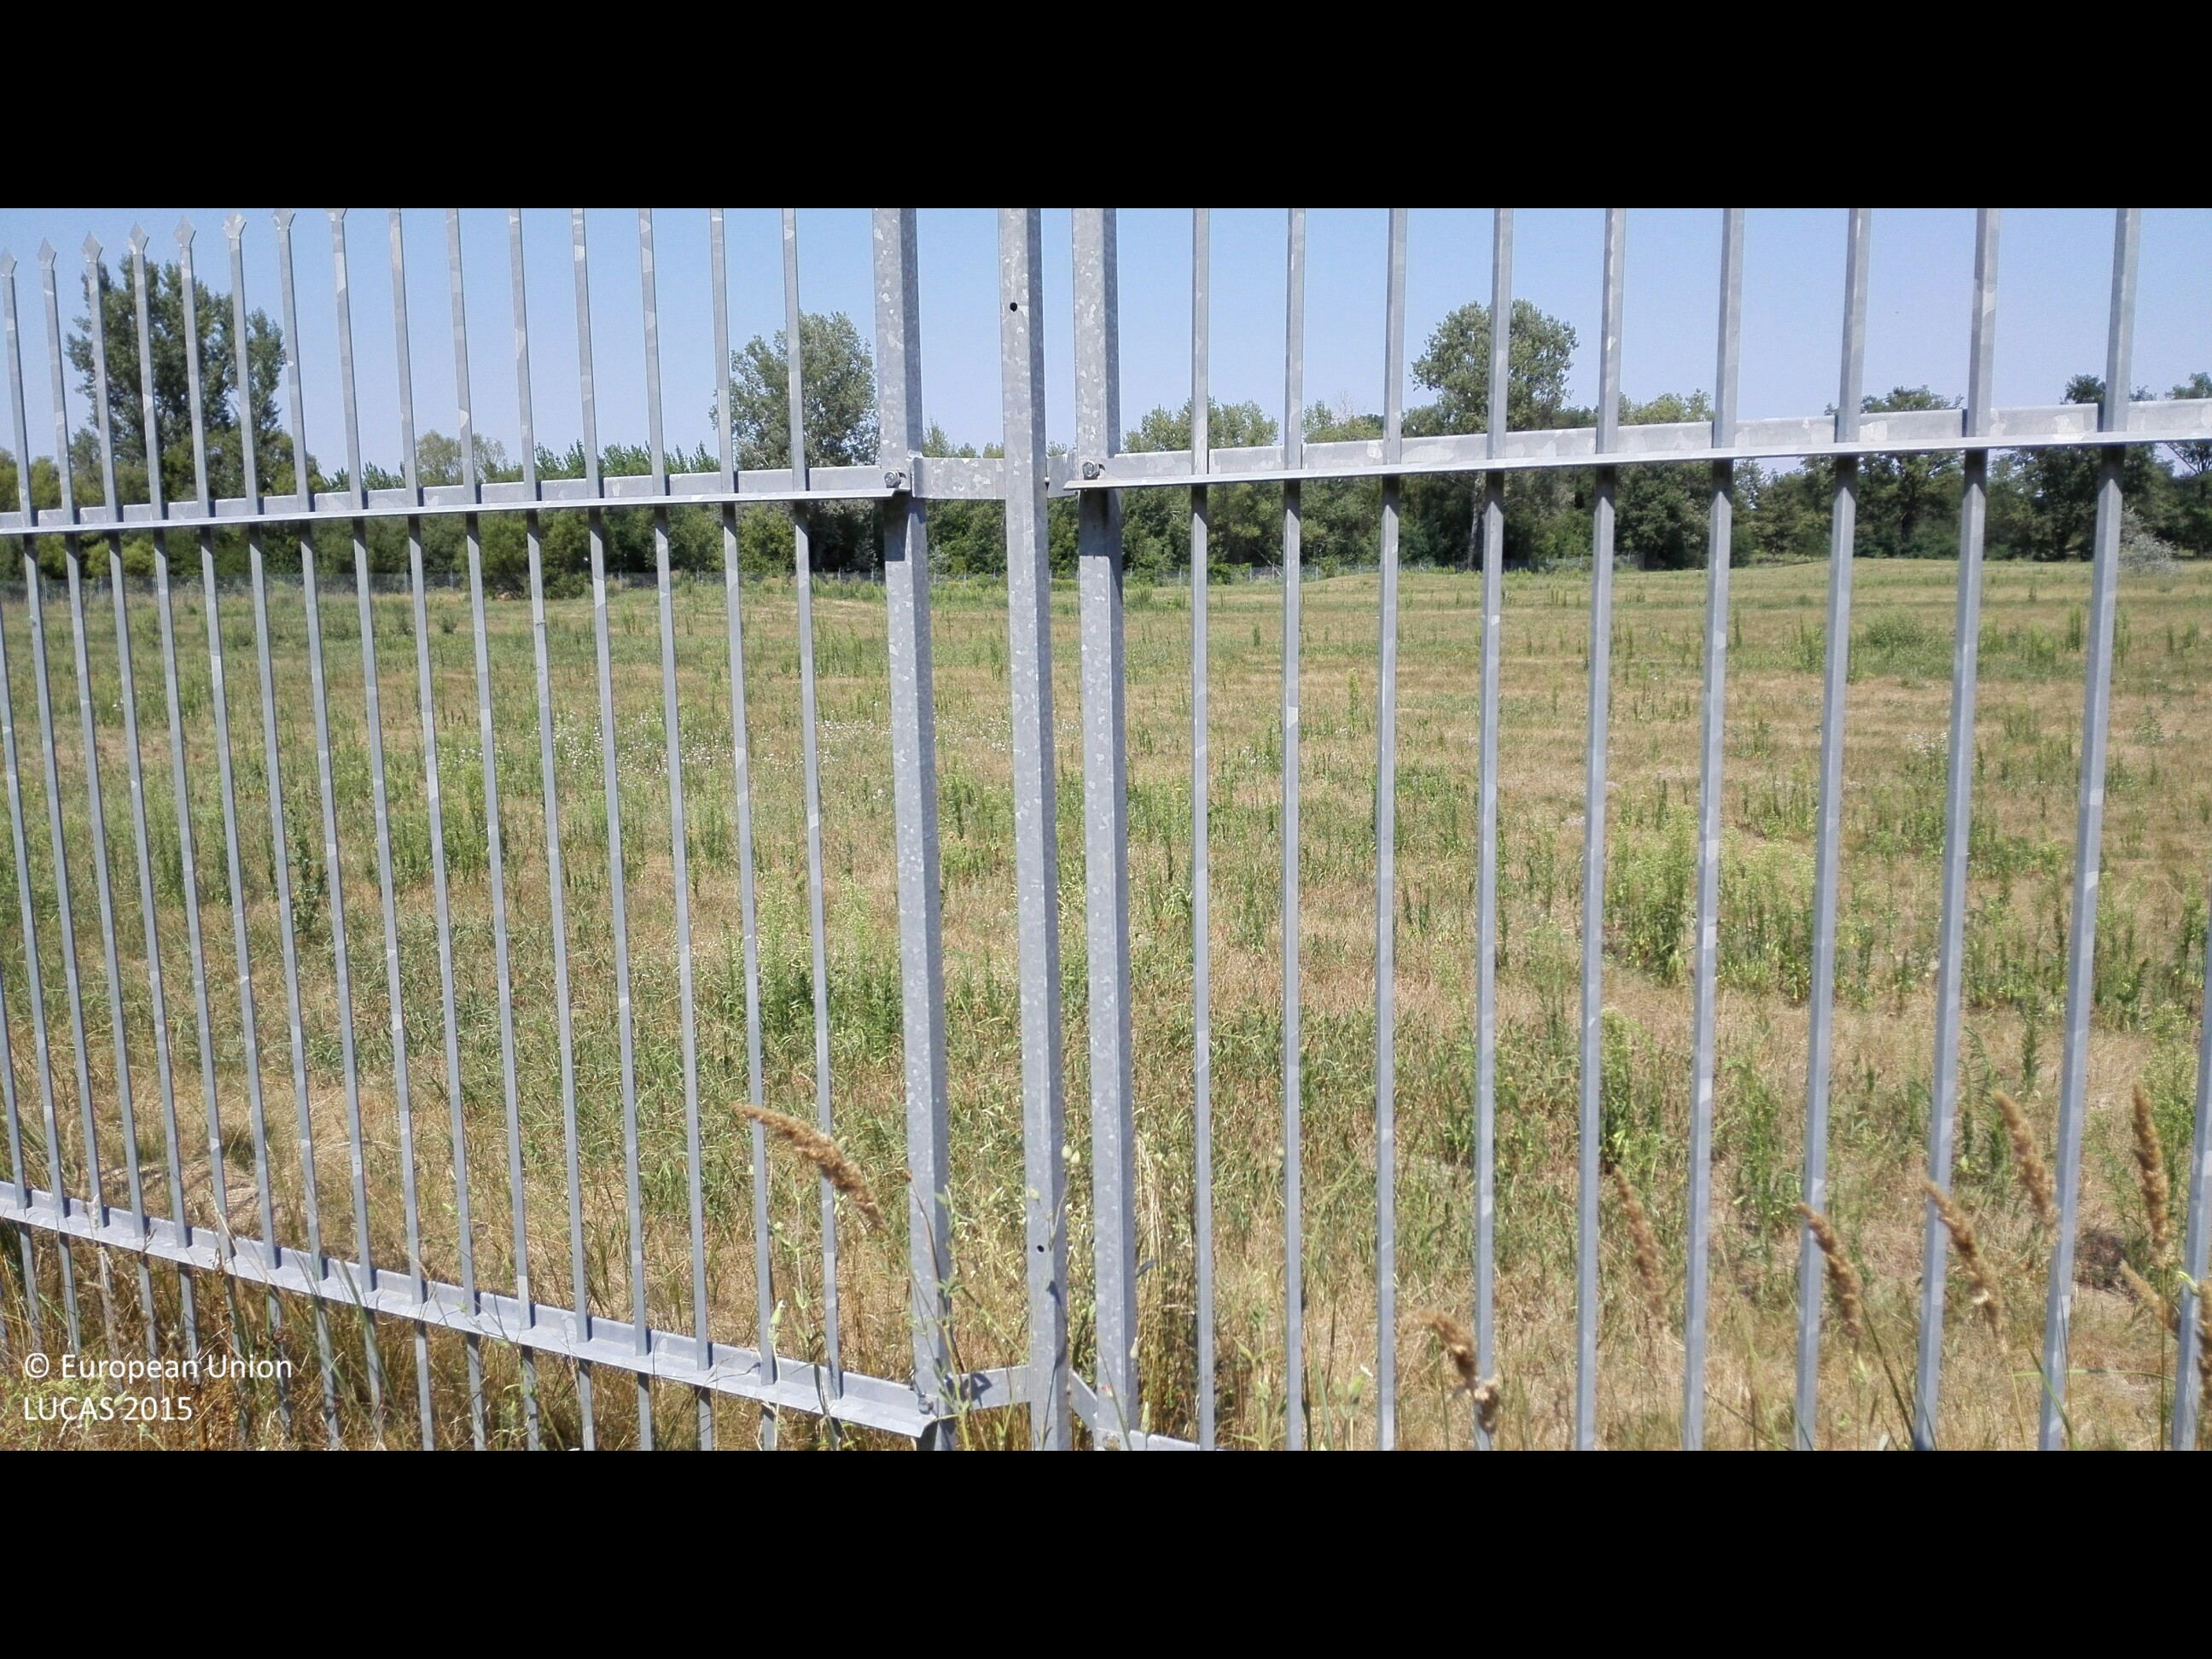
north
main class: Grassland
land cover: Grassland without tree/shrub cover
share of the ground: > 75 %
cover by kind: herbaceous plants 100 %
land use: Sport
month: August
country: HU
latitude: 47.4797
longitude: 21.9521
